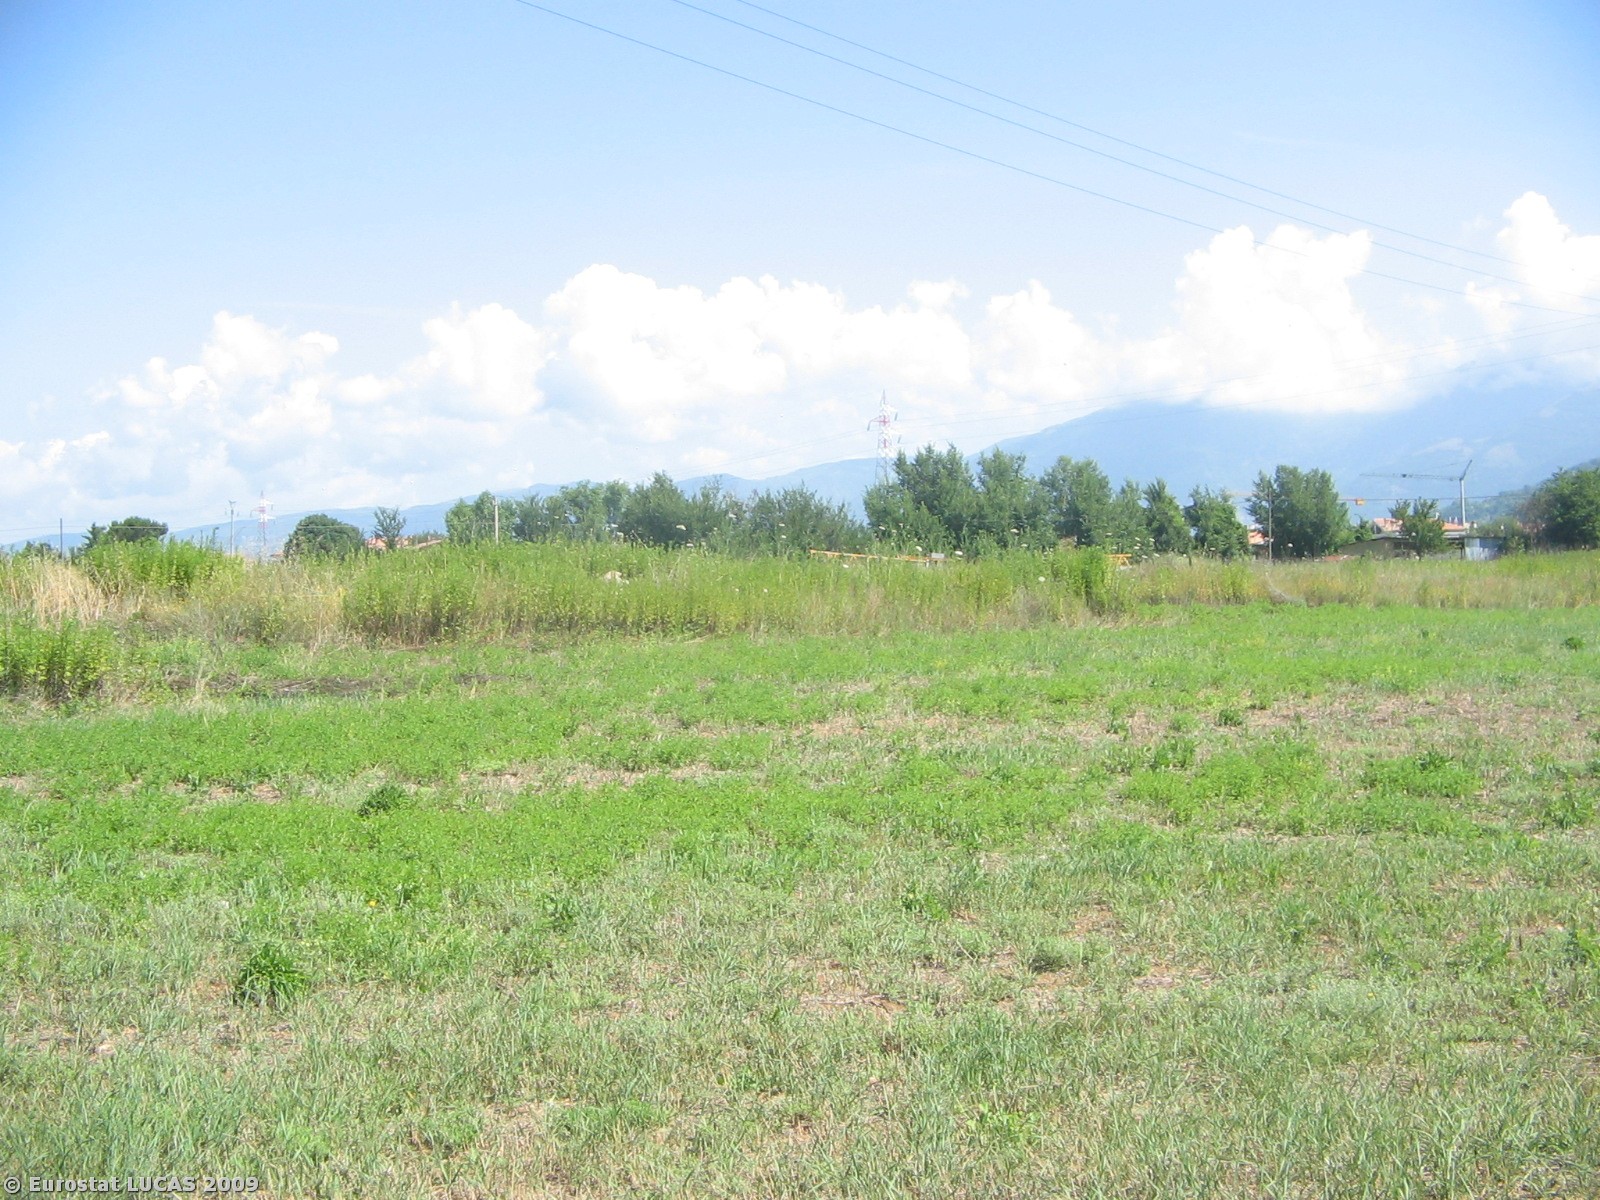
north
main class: Grassland
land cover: Spontaneously vegetated surfaces
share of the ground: > 75 %
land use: Fallow land
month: July
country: IT
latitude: 42.4152
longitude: 12.8464
